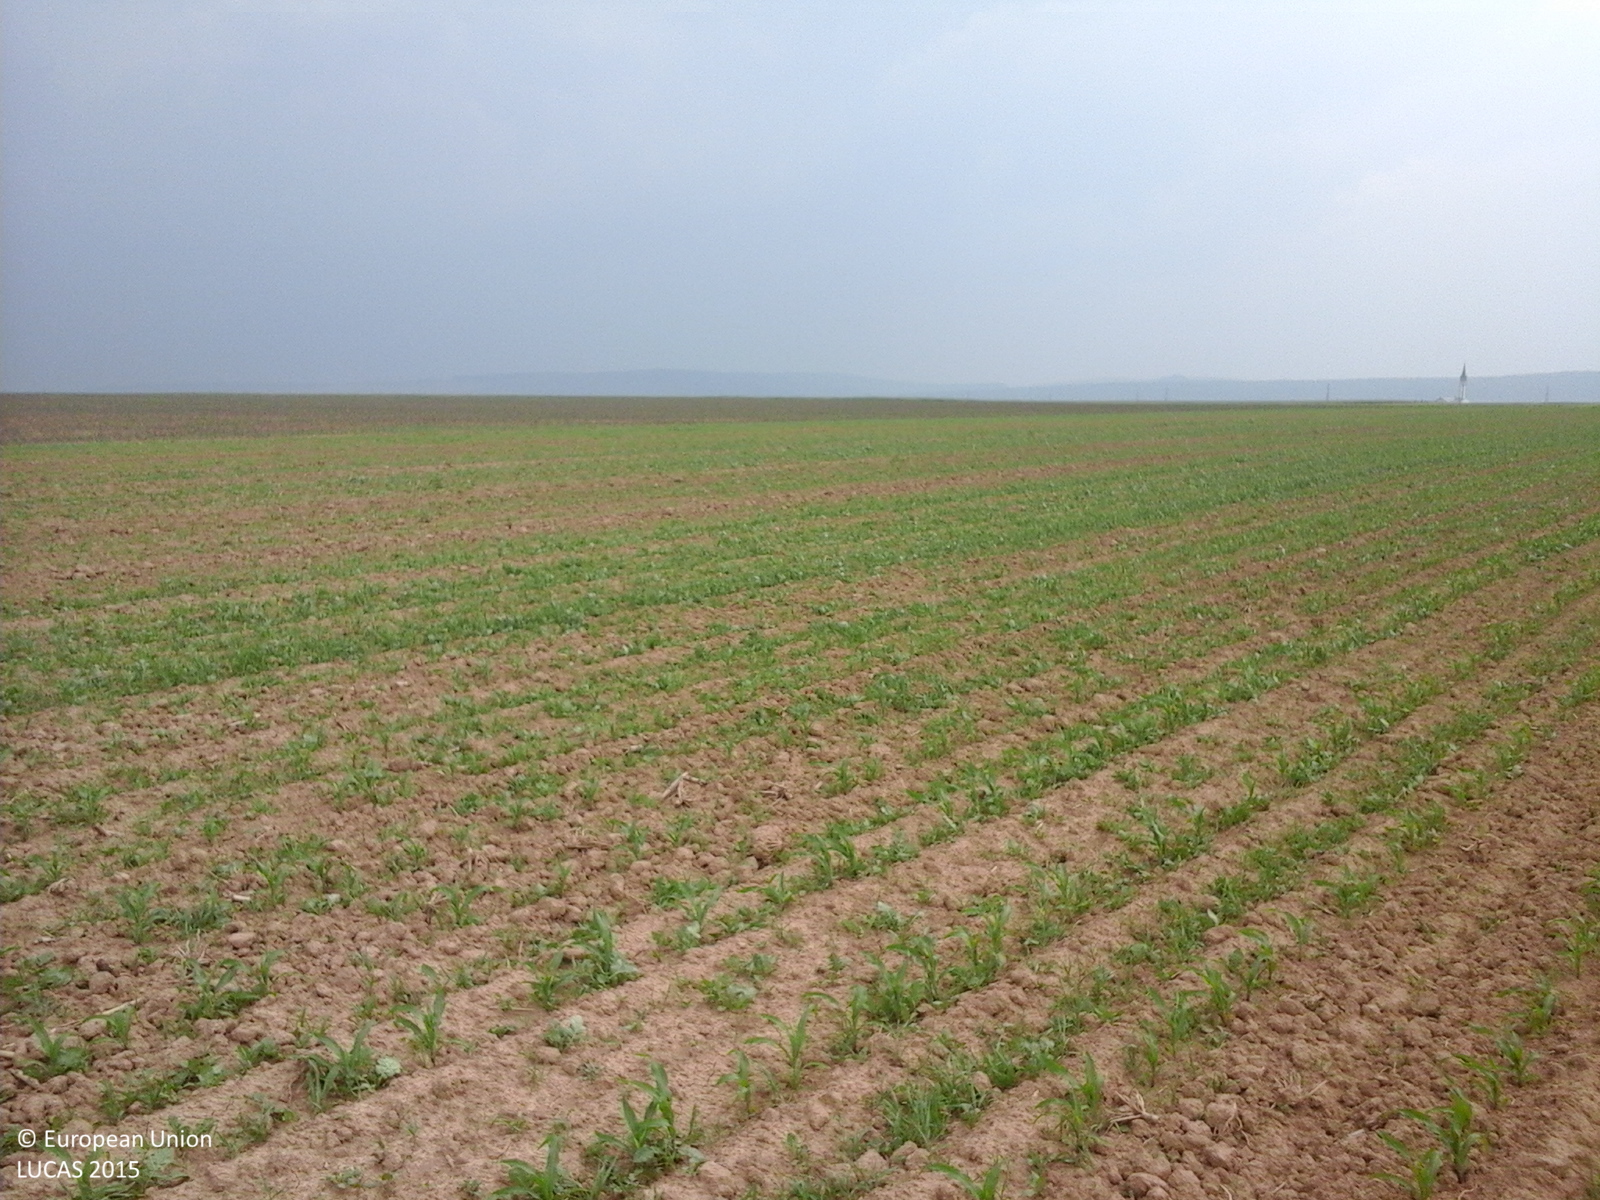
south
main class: Cropland
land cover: Maize
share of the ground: 25 - 50 %
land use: Agriculture (excluding fallow land and kitchen gardens)
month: June
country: RO
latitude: 47.0938
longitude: 26.7587
